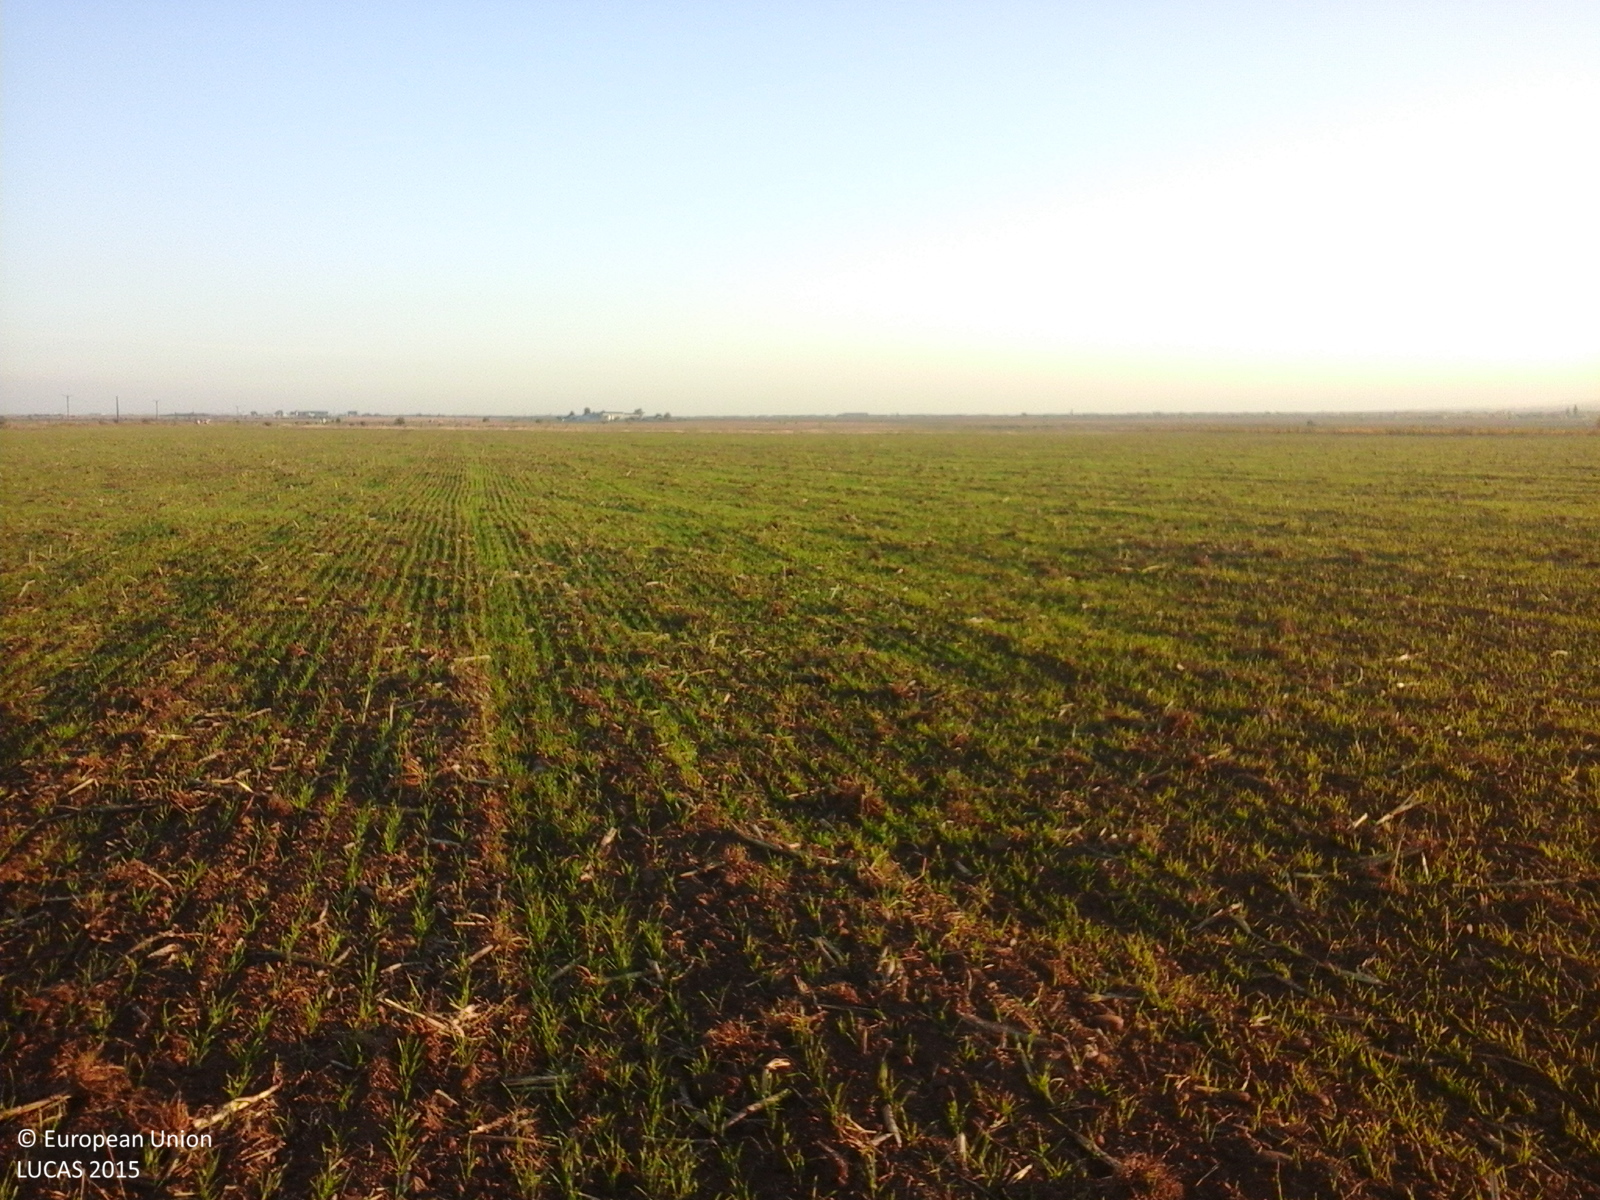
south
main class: Cropland
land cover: Common wheat
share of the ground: 10 - 25 %
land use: Agriculture (excluding fallow land and kitchen gardens)
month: October
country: RO
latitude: 45.7869
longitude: 27.1114
